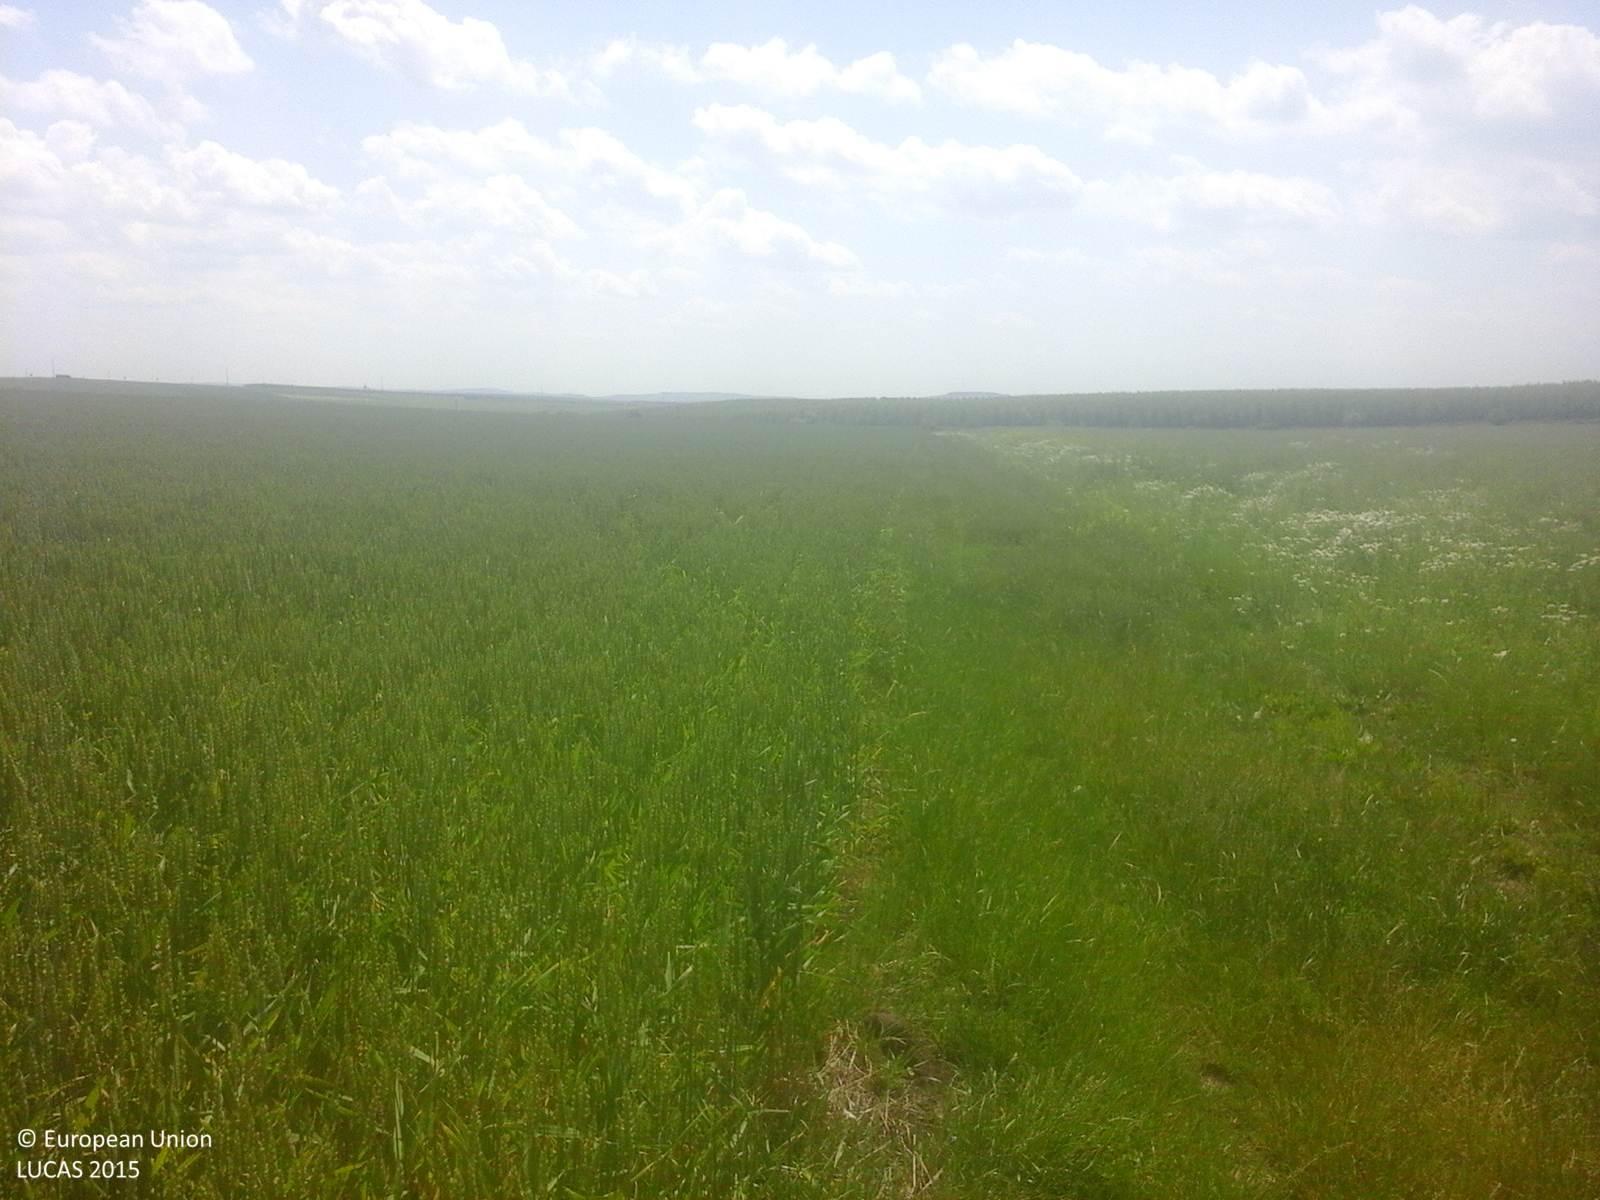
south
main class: Cropland
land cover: Common wheat
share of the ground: > 75 %
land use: Agriculture (excluding fallow land and kitchen gardens)
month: June
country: RO
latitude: 47.9052
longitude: 26.0117
